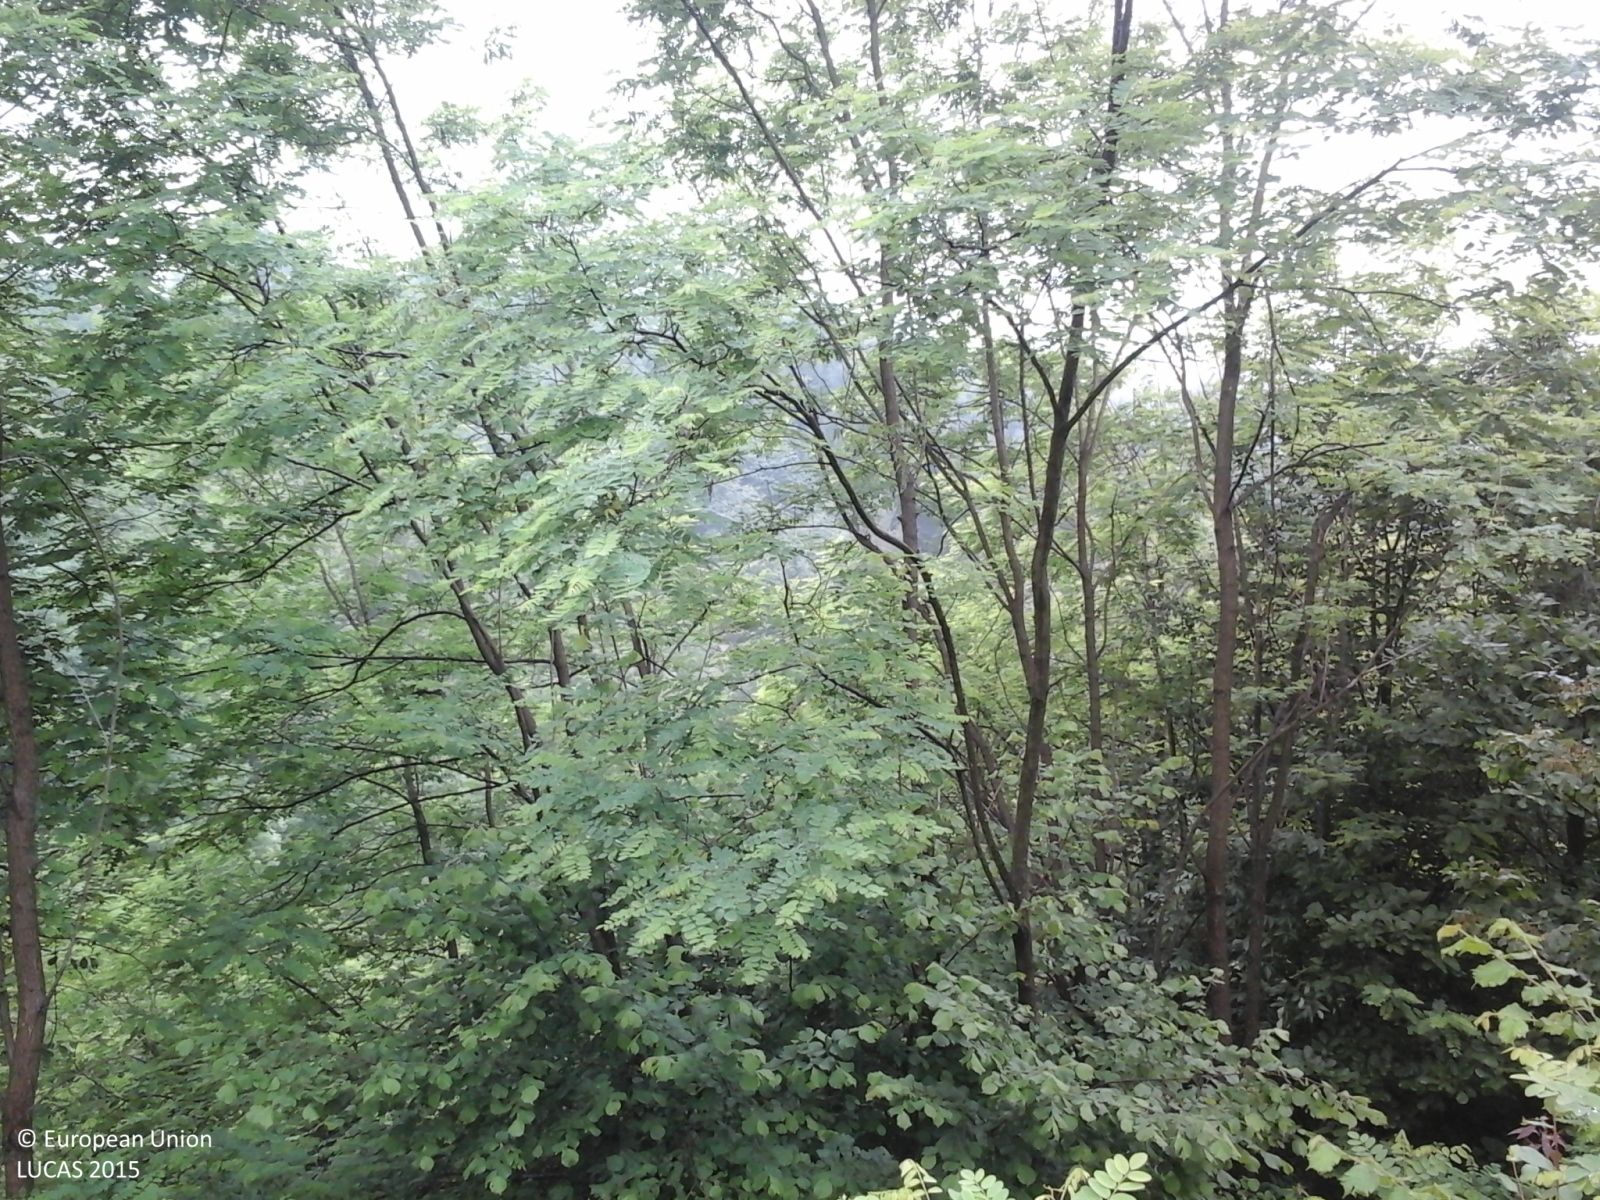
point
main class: Woodland
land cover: Broadleaved woodland
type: mesophytic deciduous forest
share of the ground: > 75 %
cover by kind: broadleaved forest trees 100 %
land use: Forestry
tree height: > 5 m
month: May
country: IT
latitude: 45.6512
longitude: 8.1935
